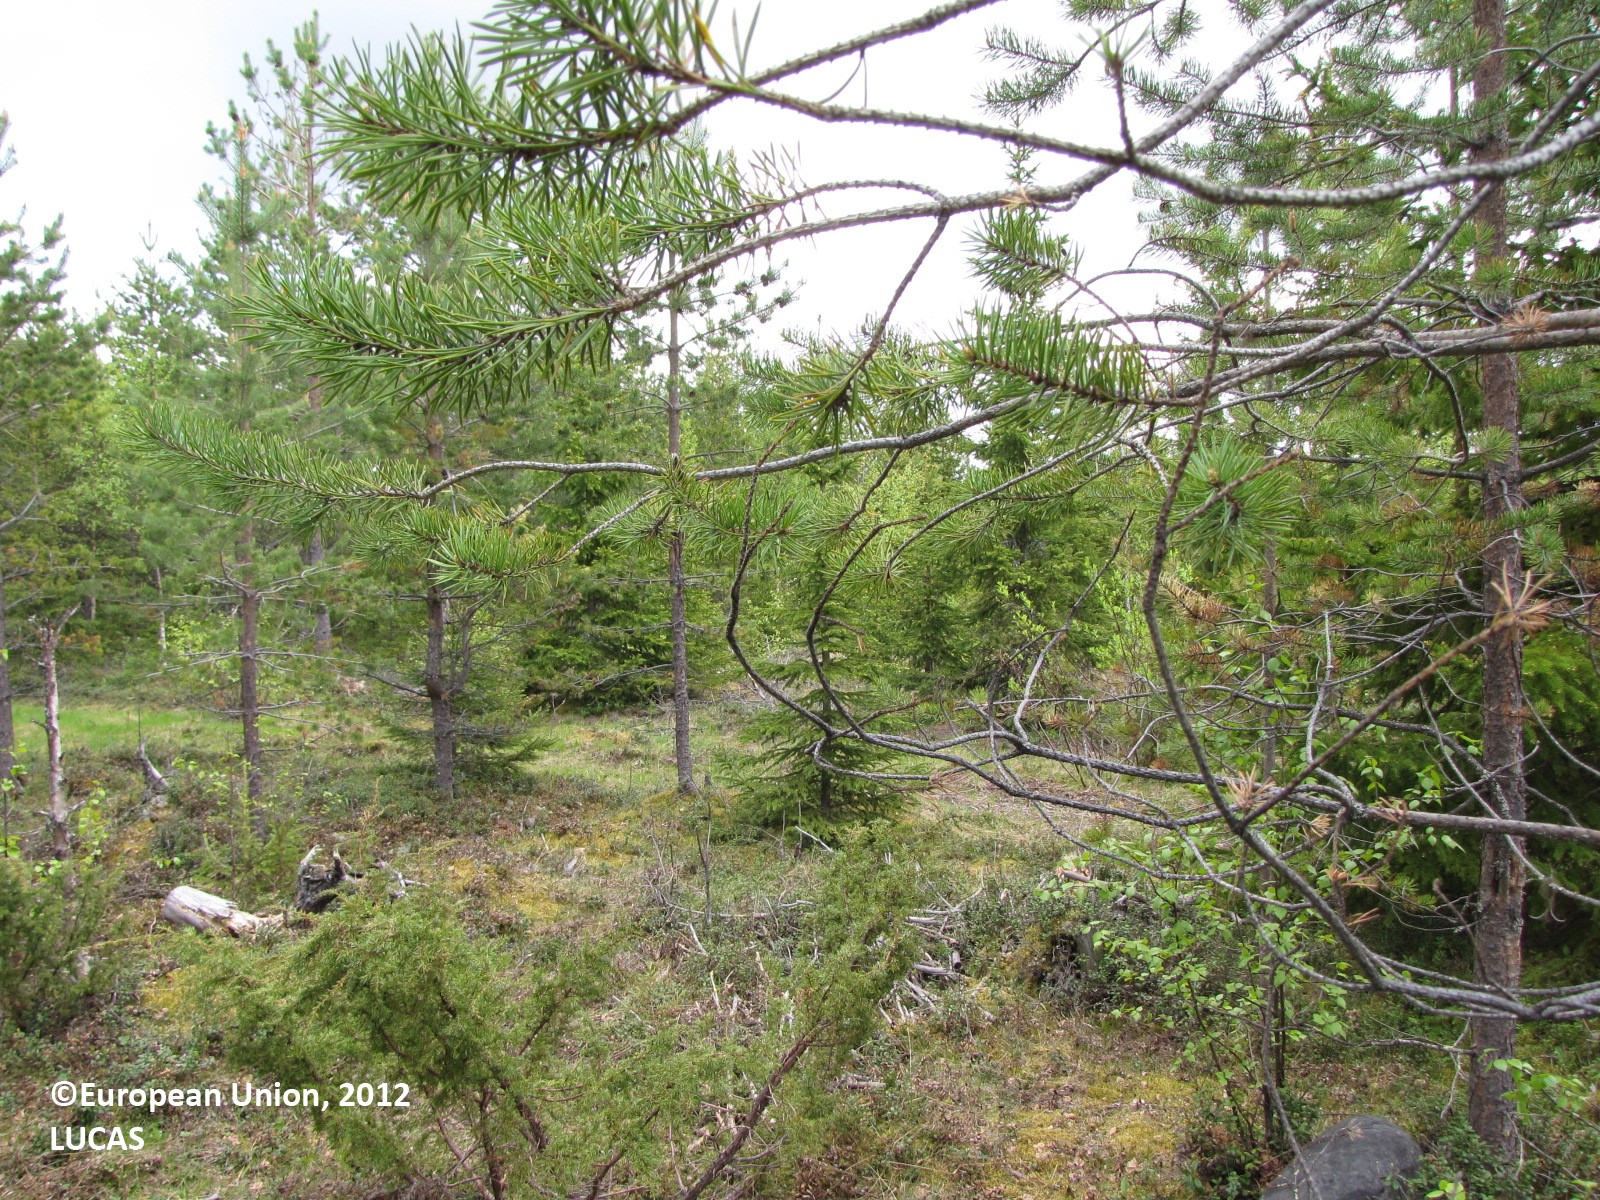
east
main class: Woodland
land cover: Other coniferous woodland
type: boreal forest
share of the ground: 25 - 50 %
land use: Forestry
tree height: > 5 m
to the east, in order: Other coniferous woodland; Spruce dominated mixed woodland; Tracks; Spruce dominated mixed woodland; Pine dominated mixed woodland; Spruce dominated mixed woodland; Paved roads, cycling and walking lanes; Pine dominated coniferous woodland
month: June
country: FI
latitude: 65.8525
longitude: 24.6680
